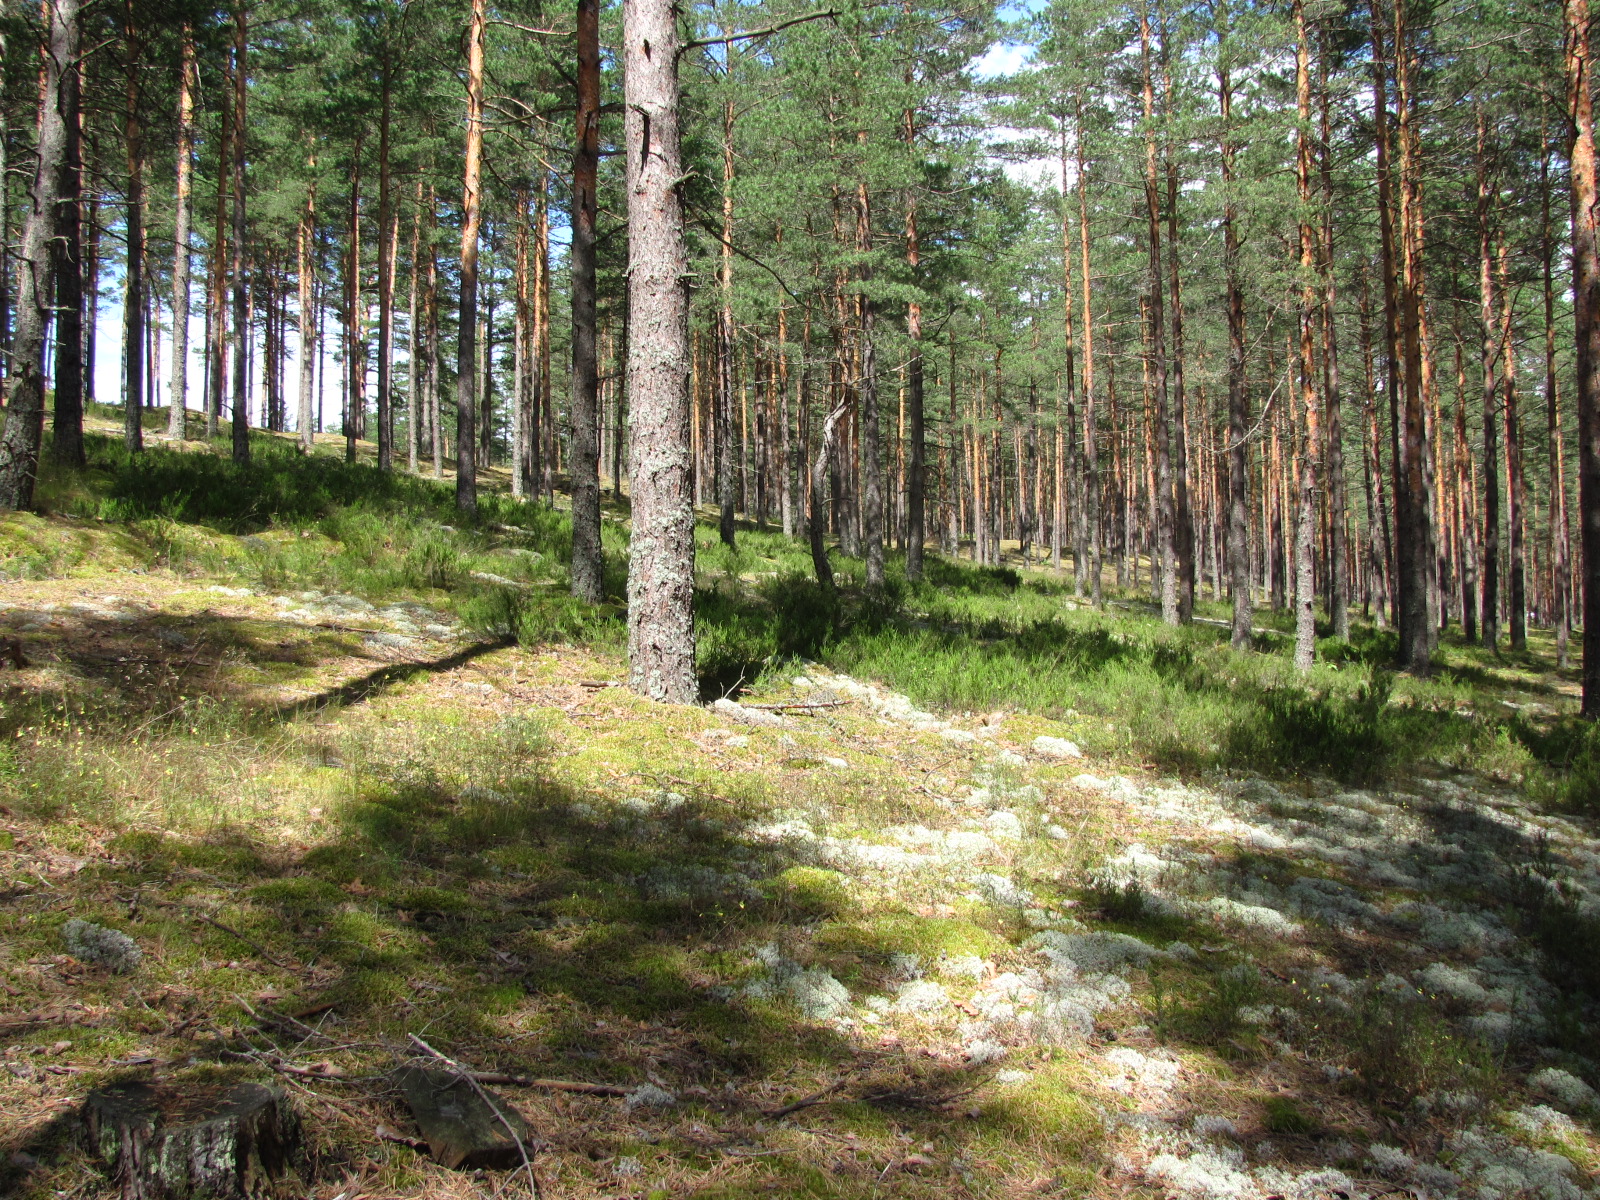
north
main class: Woodland
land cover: Pine dominated coniferous woodland
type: hemiboreal forest and nemoral coniferous forest and mixed broadleaved-coniferous forest
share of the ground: > 75 %
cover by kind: coniferous forest trees 80 %, lichens and mosses 15 %, shrubs 5 %
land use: Forestry
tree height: > 5 m
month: July
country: LV
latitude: 57.0201
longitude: 24.3715
